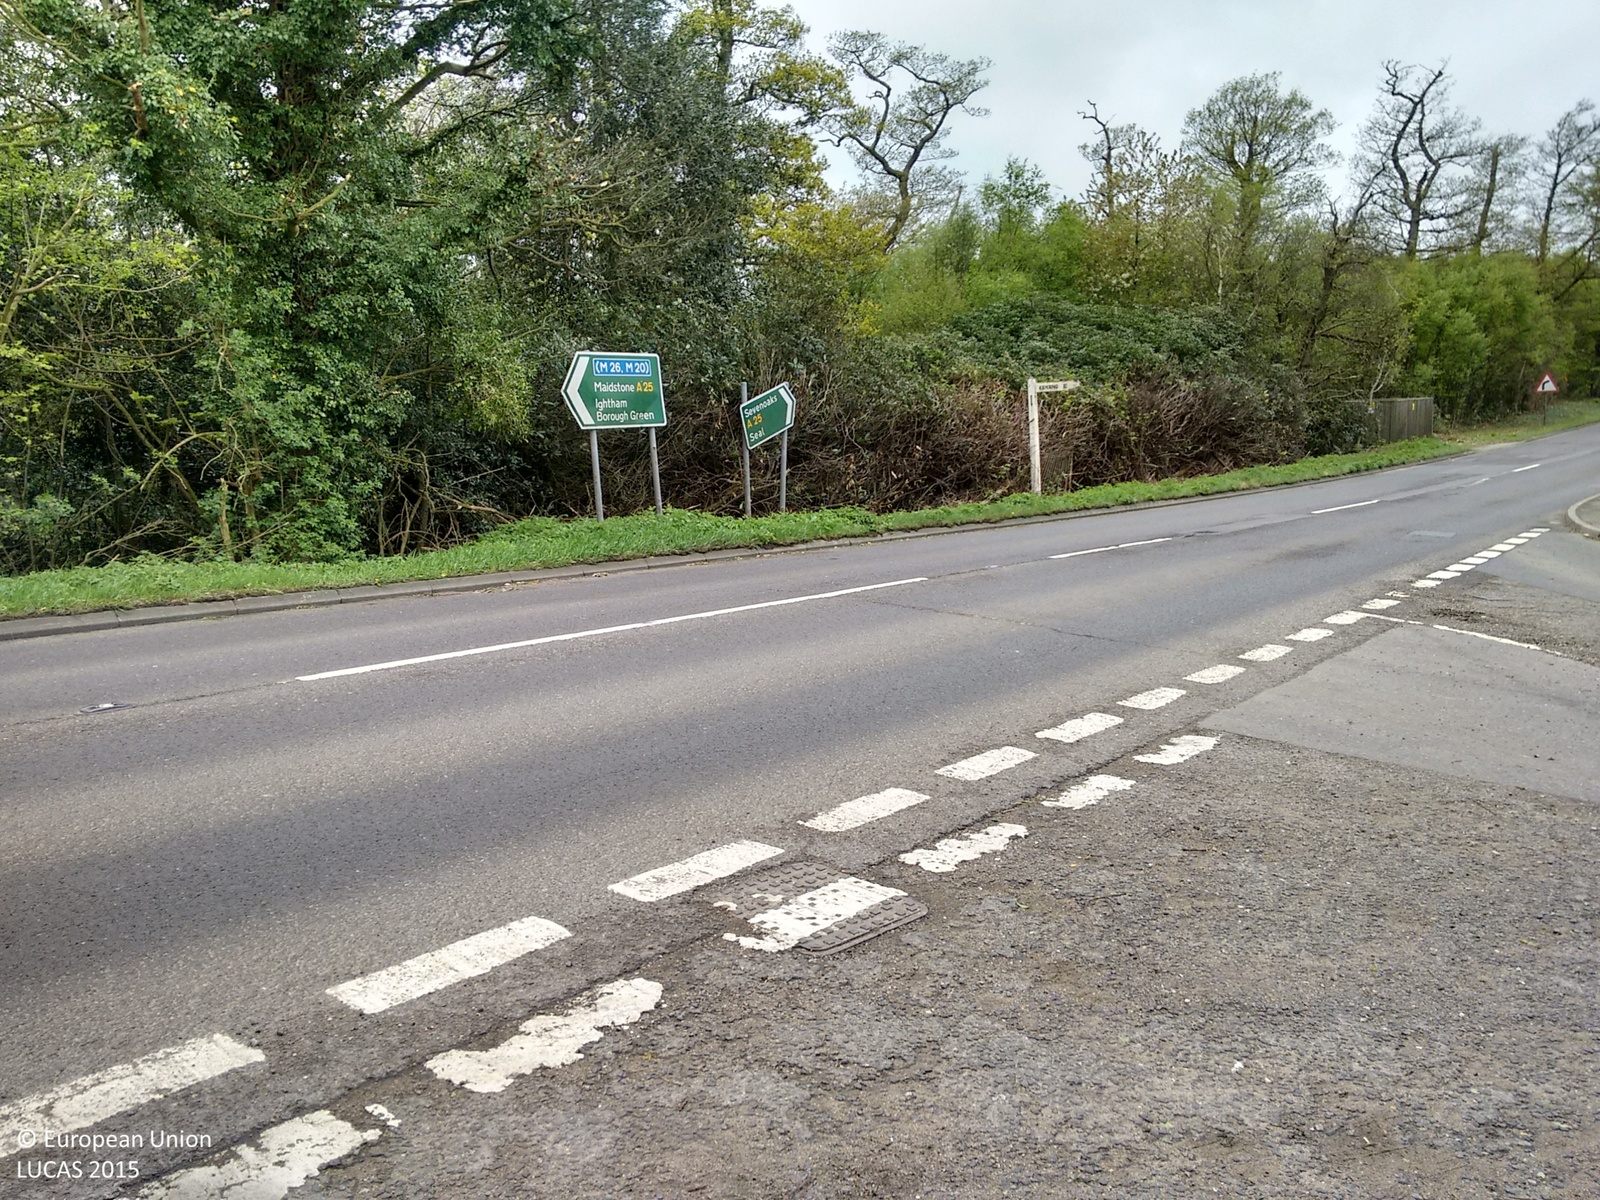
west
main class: Woodland
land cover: Broadleaved woodland
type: mesophytic deciduous forest
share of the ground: > 75 %
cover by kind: broadleaved forest trees 80 %, shrubs 20 %
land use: Forestry
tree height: > 5 m
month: May
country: GB
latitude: 51.2856
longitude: 0.2339
